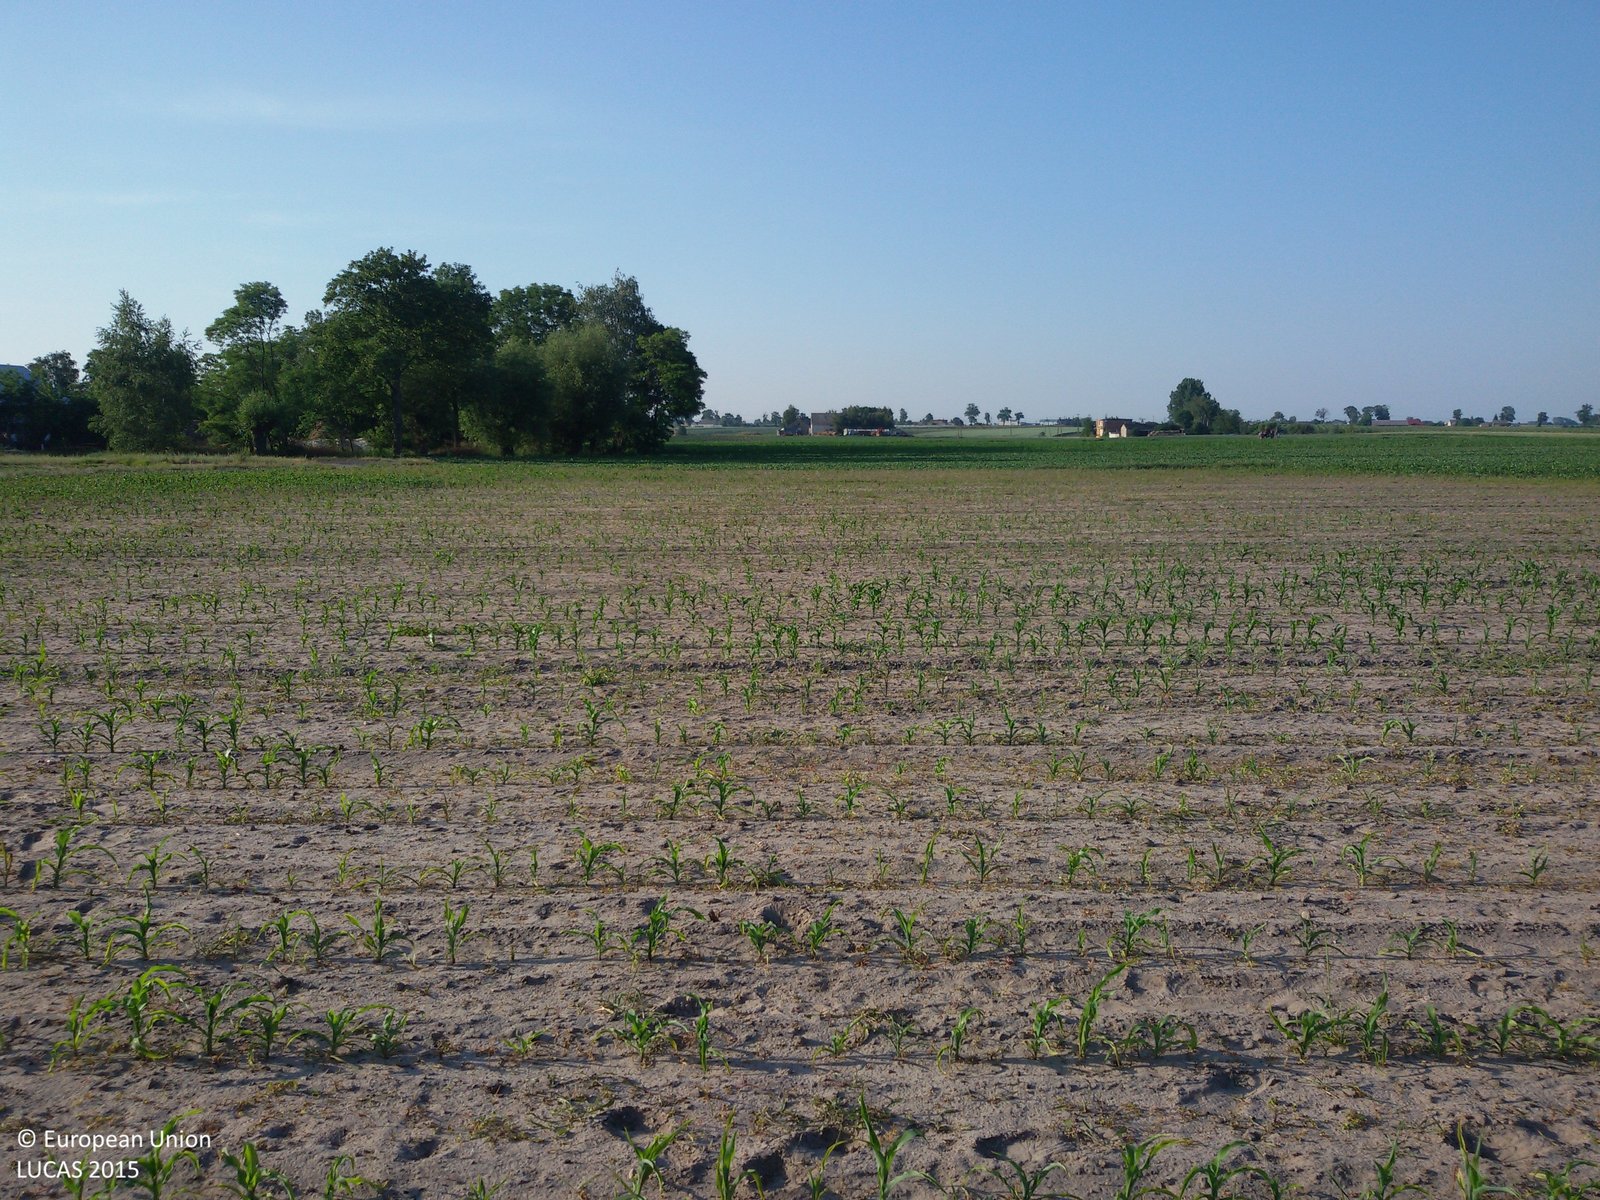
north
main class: Cropland
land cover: Maize
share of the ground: 25 - 50 %
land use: Agriculture (excluding fallow land and kitchen gardens)
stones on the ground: < 10 %
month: June
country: PL
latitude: 52.5036
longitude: 19.0245
